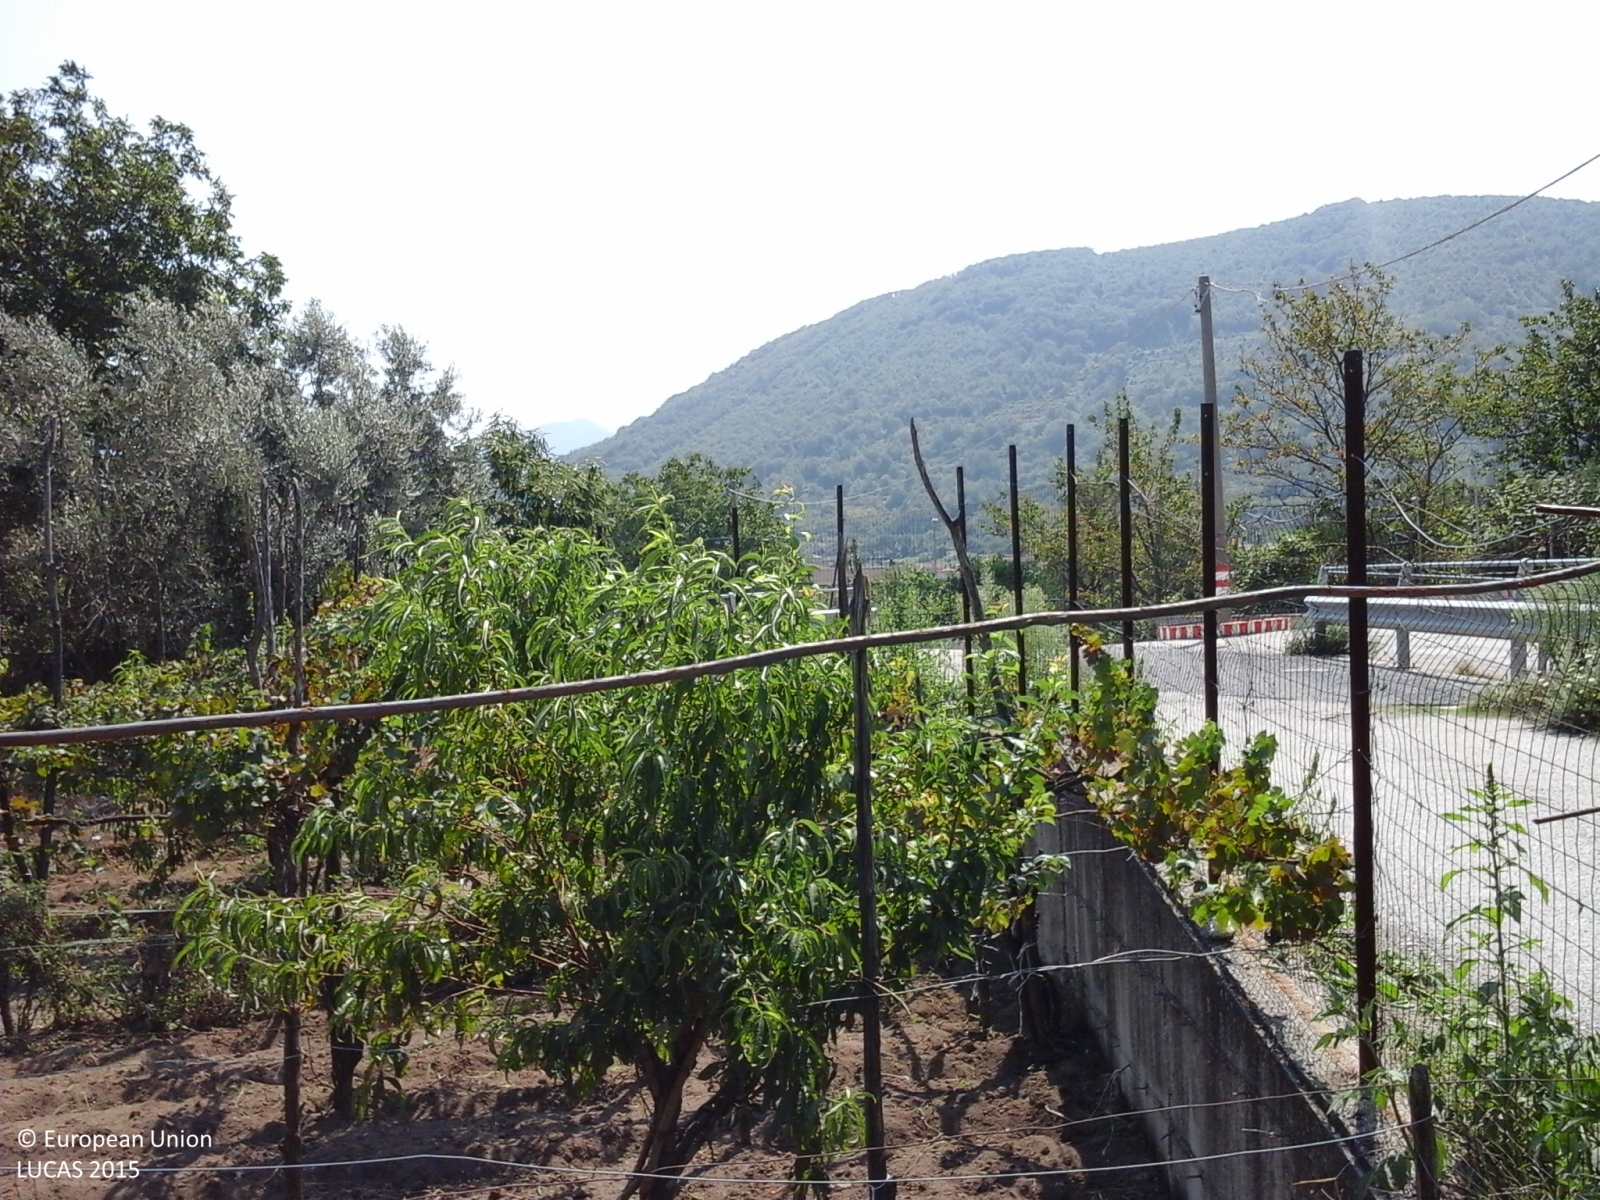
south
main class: Cropland
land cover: Vineyards
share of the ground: 25 - 50 %
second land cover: Tomatoes
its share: < 10 %
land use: Agriculture (excluding fallow land and kitchen gardens)
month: August
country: IT
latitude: 40.8077
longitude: 14.6869
